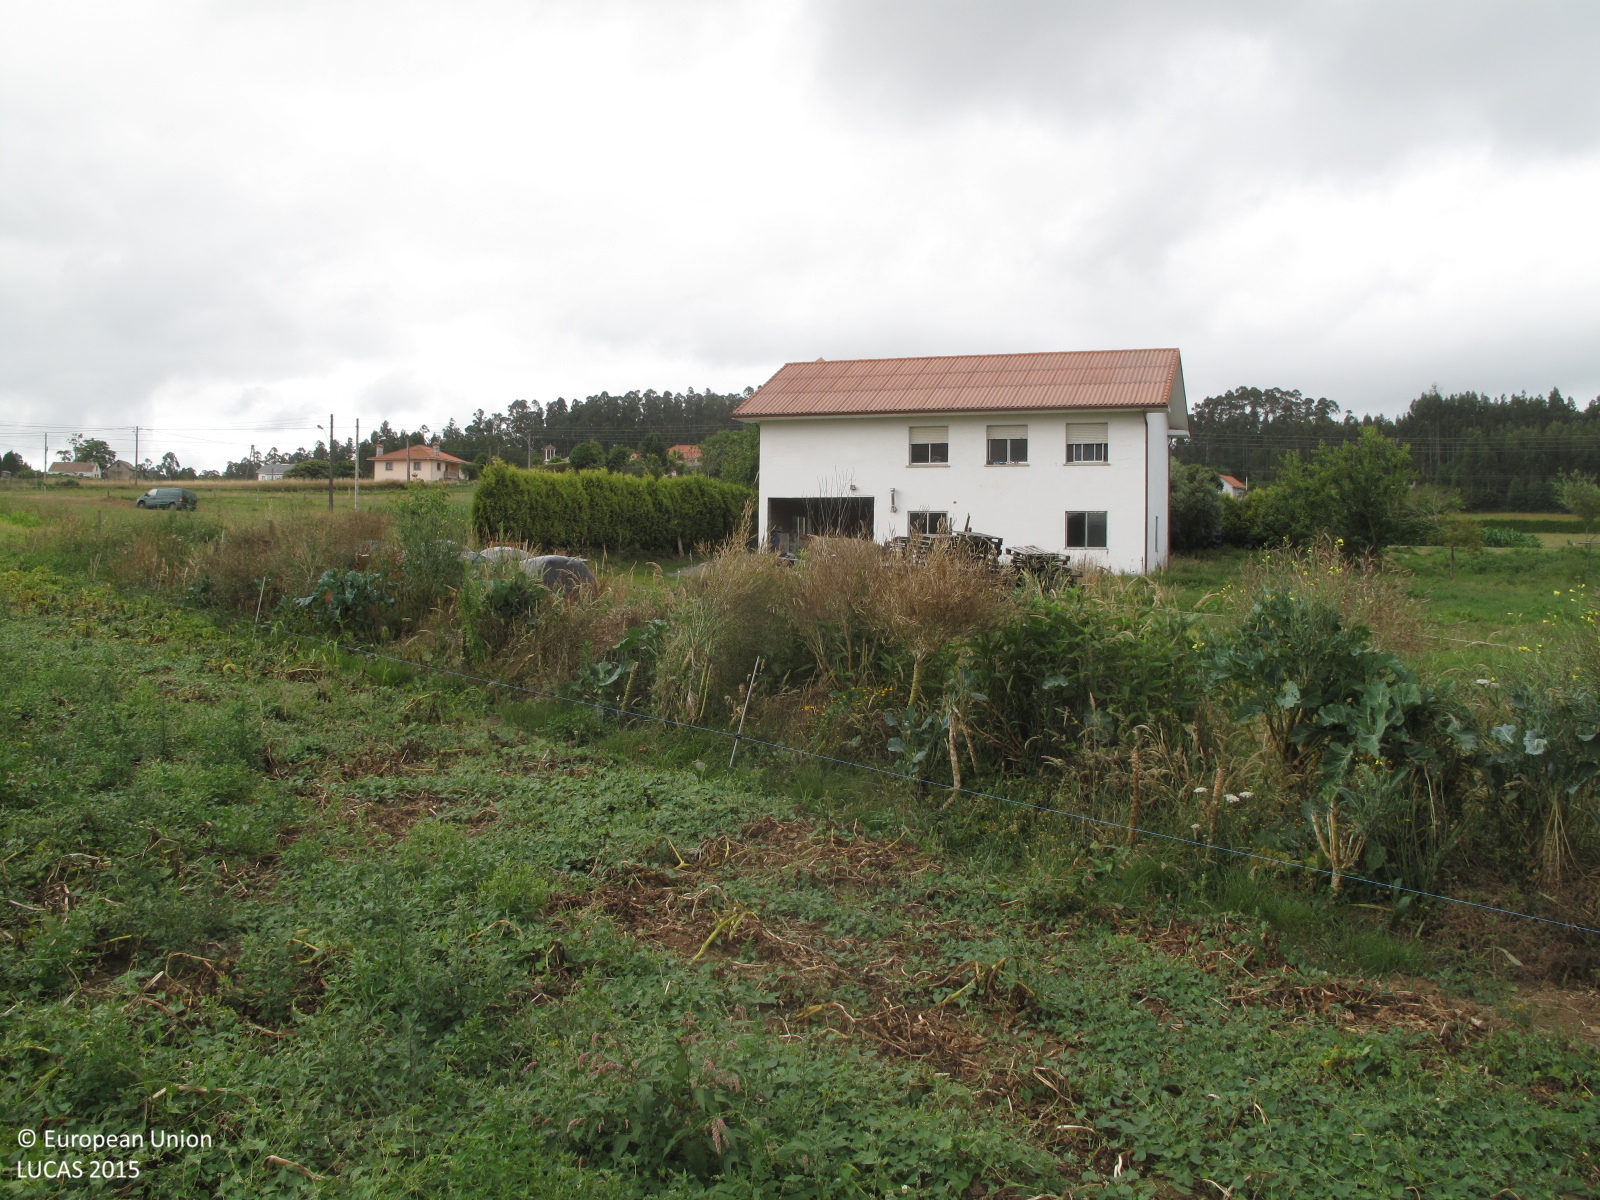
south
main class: Cropland
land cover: Potatoes
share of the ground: 25 - 50 %
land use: Kitchen garden
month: July
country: ES
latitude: 43.5960
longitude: -8.0732
